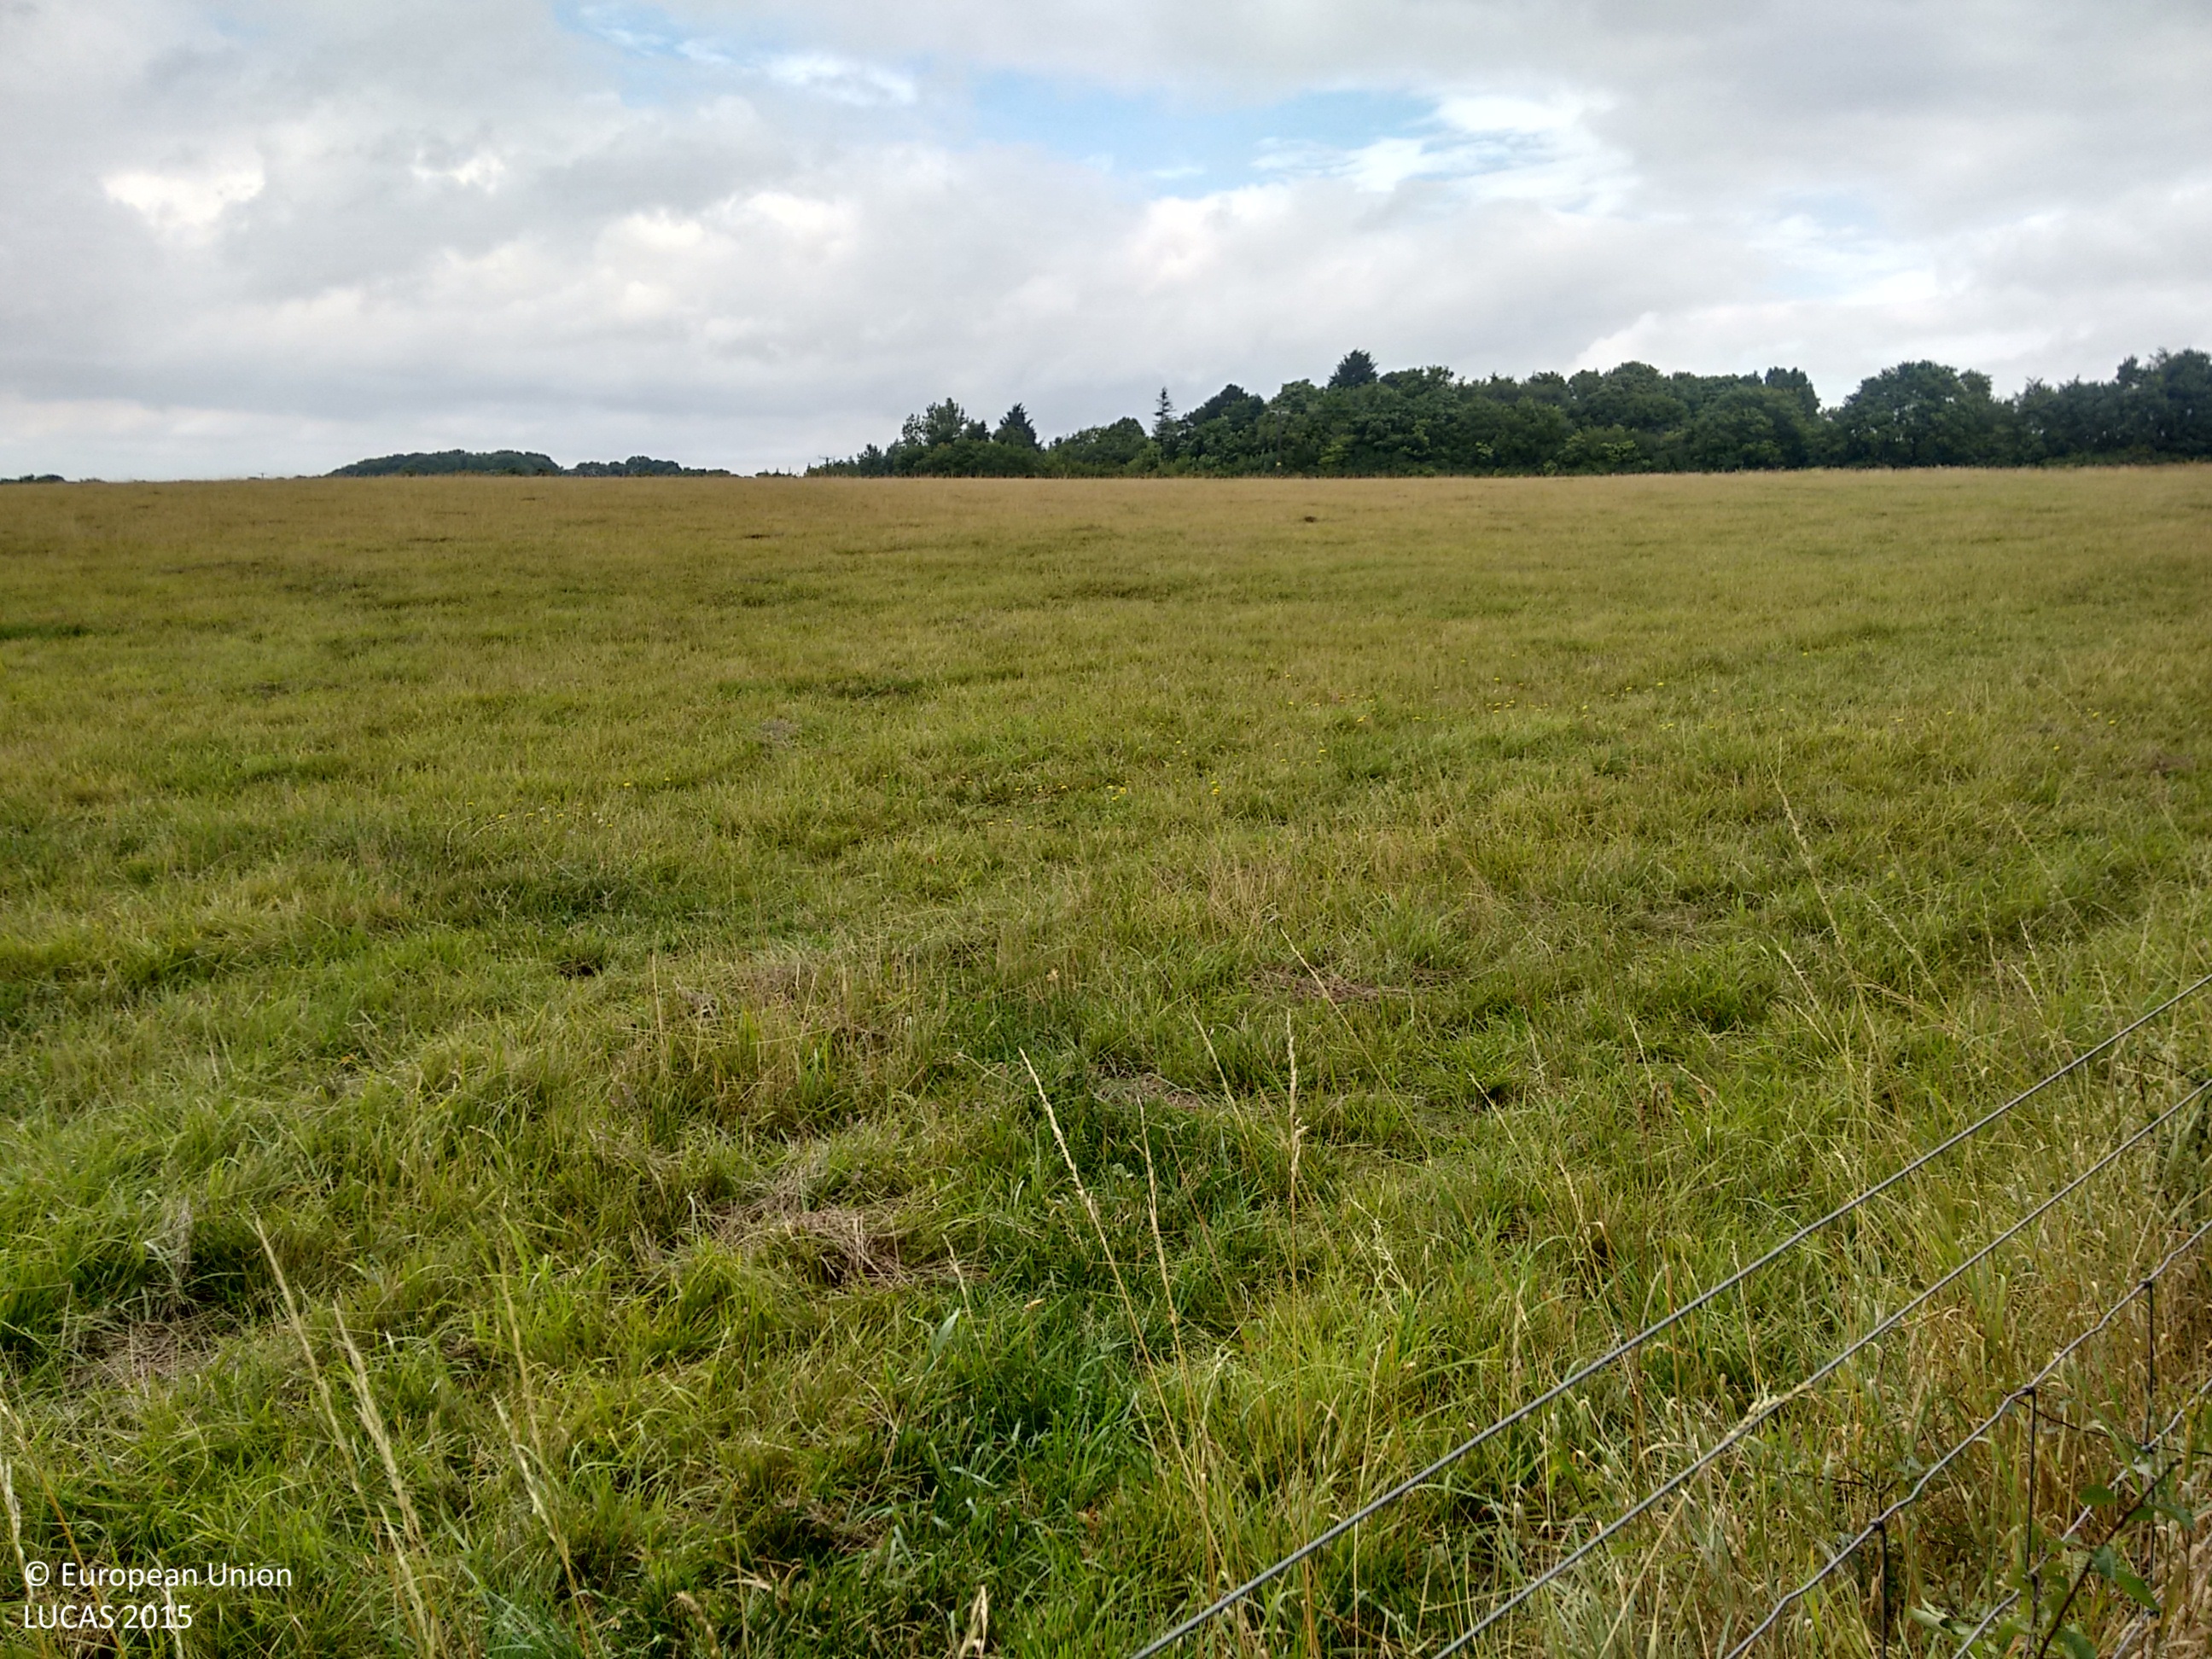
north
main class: Grassland
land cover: Grassland without tree/shrub cover
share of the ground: > 75 %
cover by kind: herbaceous plants 100 %
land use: Agriculture (excluding fallow land and kitchen gardens)
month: August
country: GB
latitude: 52.0850
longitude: 0.9429
